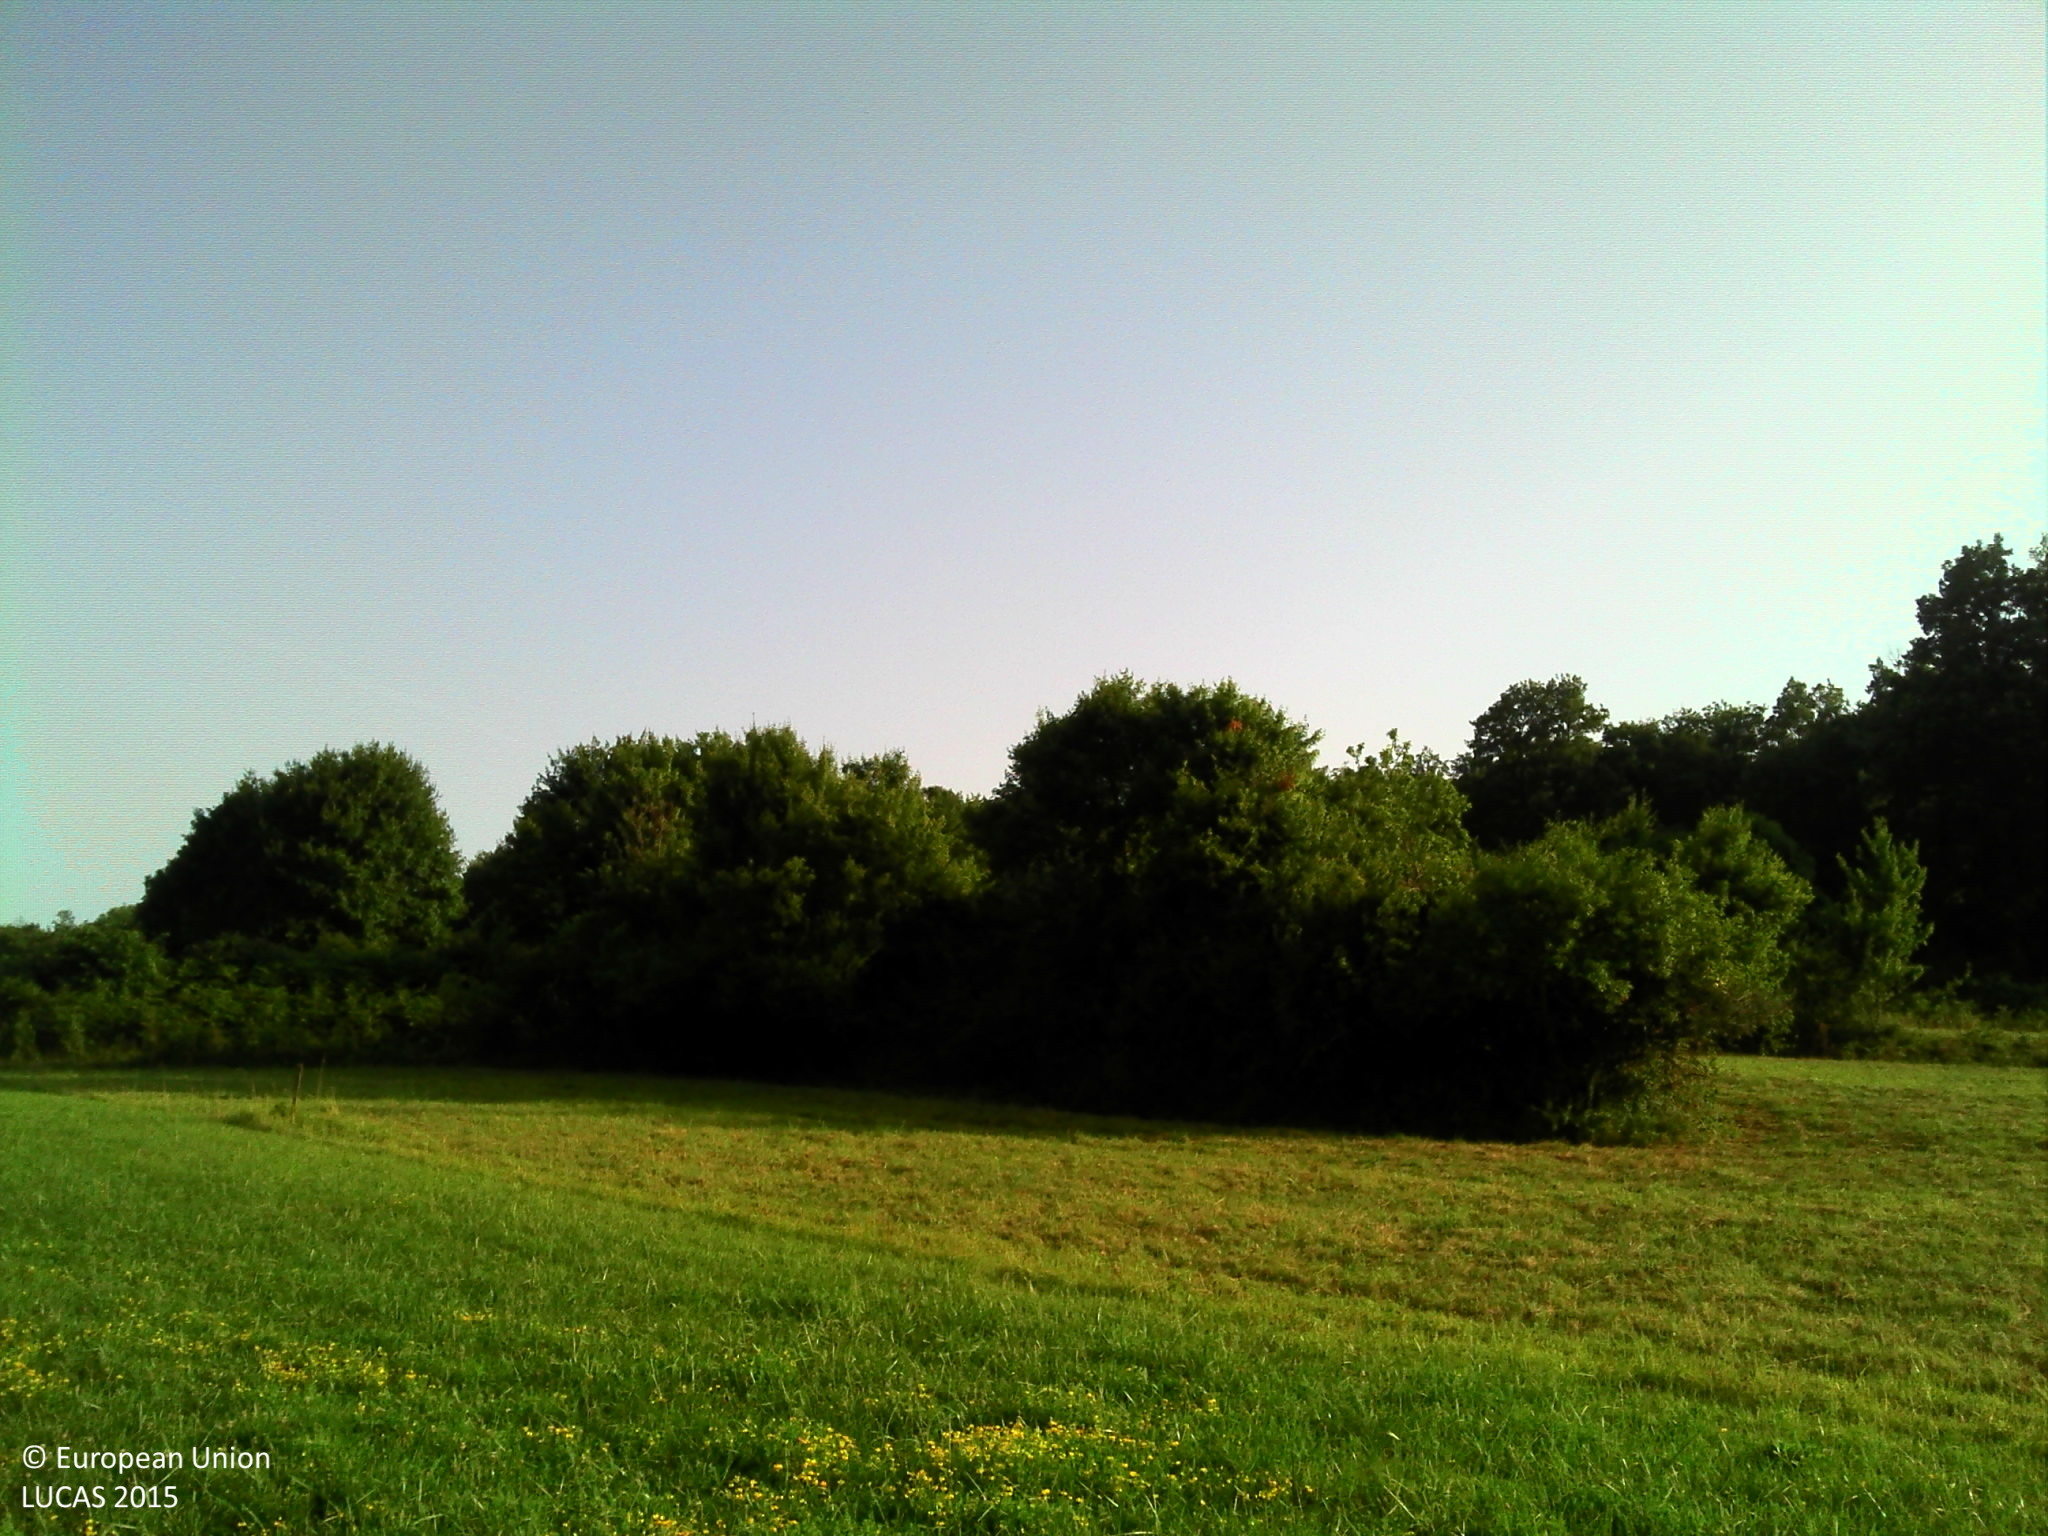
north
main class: Grassland
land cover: Grassland without tree/shrub cover
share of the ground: > 75 %
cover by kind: herbaceous plants 100 %
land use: Agriculture (excluding fallow land and kitchen gardens)
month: July
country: FR
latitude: 43.1300
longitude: 1.0667
